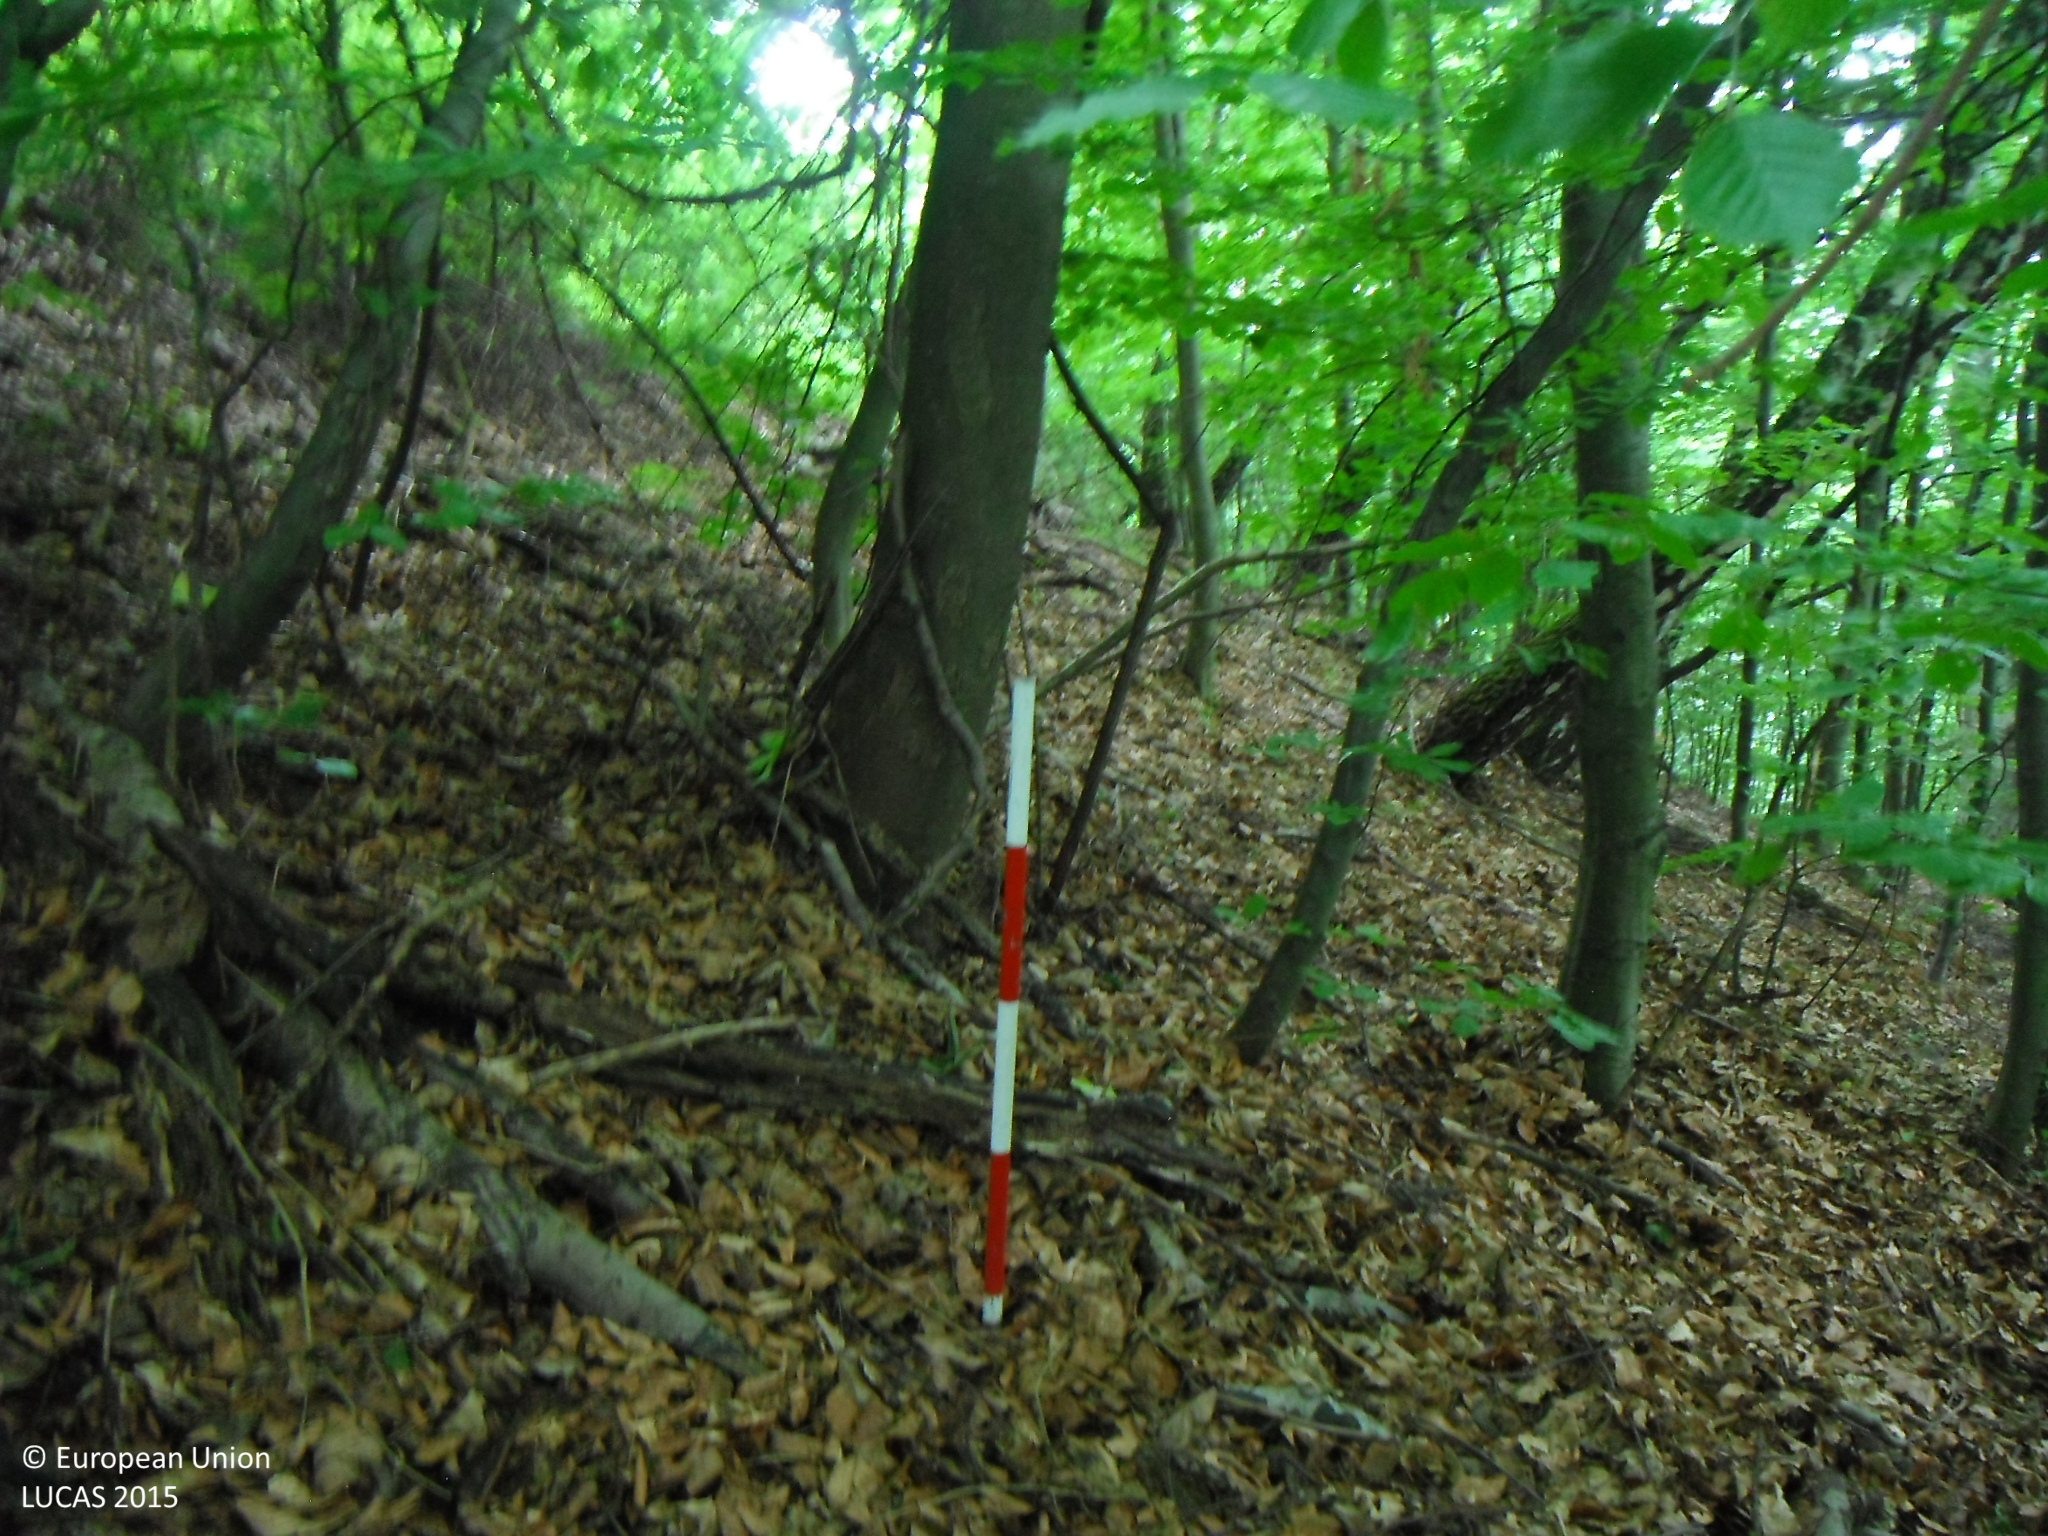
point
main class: Woodland
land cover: Broadleaved woodland
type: beech forest
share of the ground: > 75 %
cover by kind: broadleaved forest trees 100 %
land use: Forestry
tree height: > 5 m
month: June
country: SK
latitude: 48.6092
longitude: 19.9164
